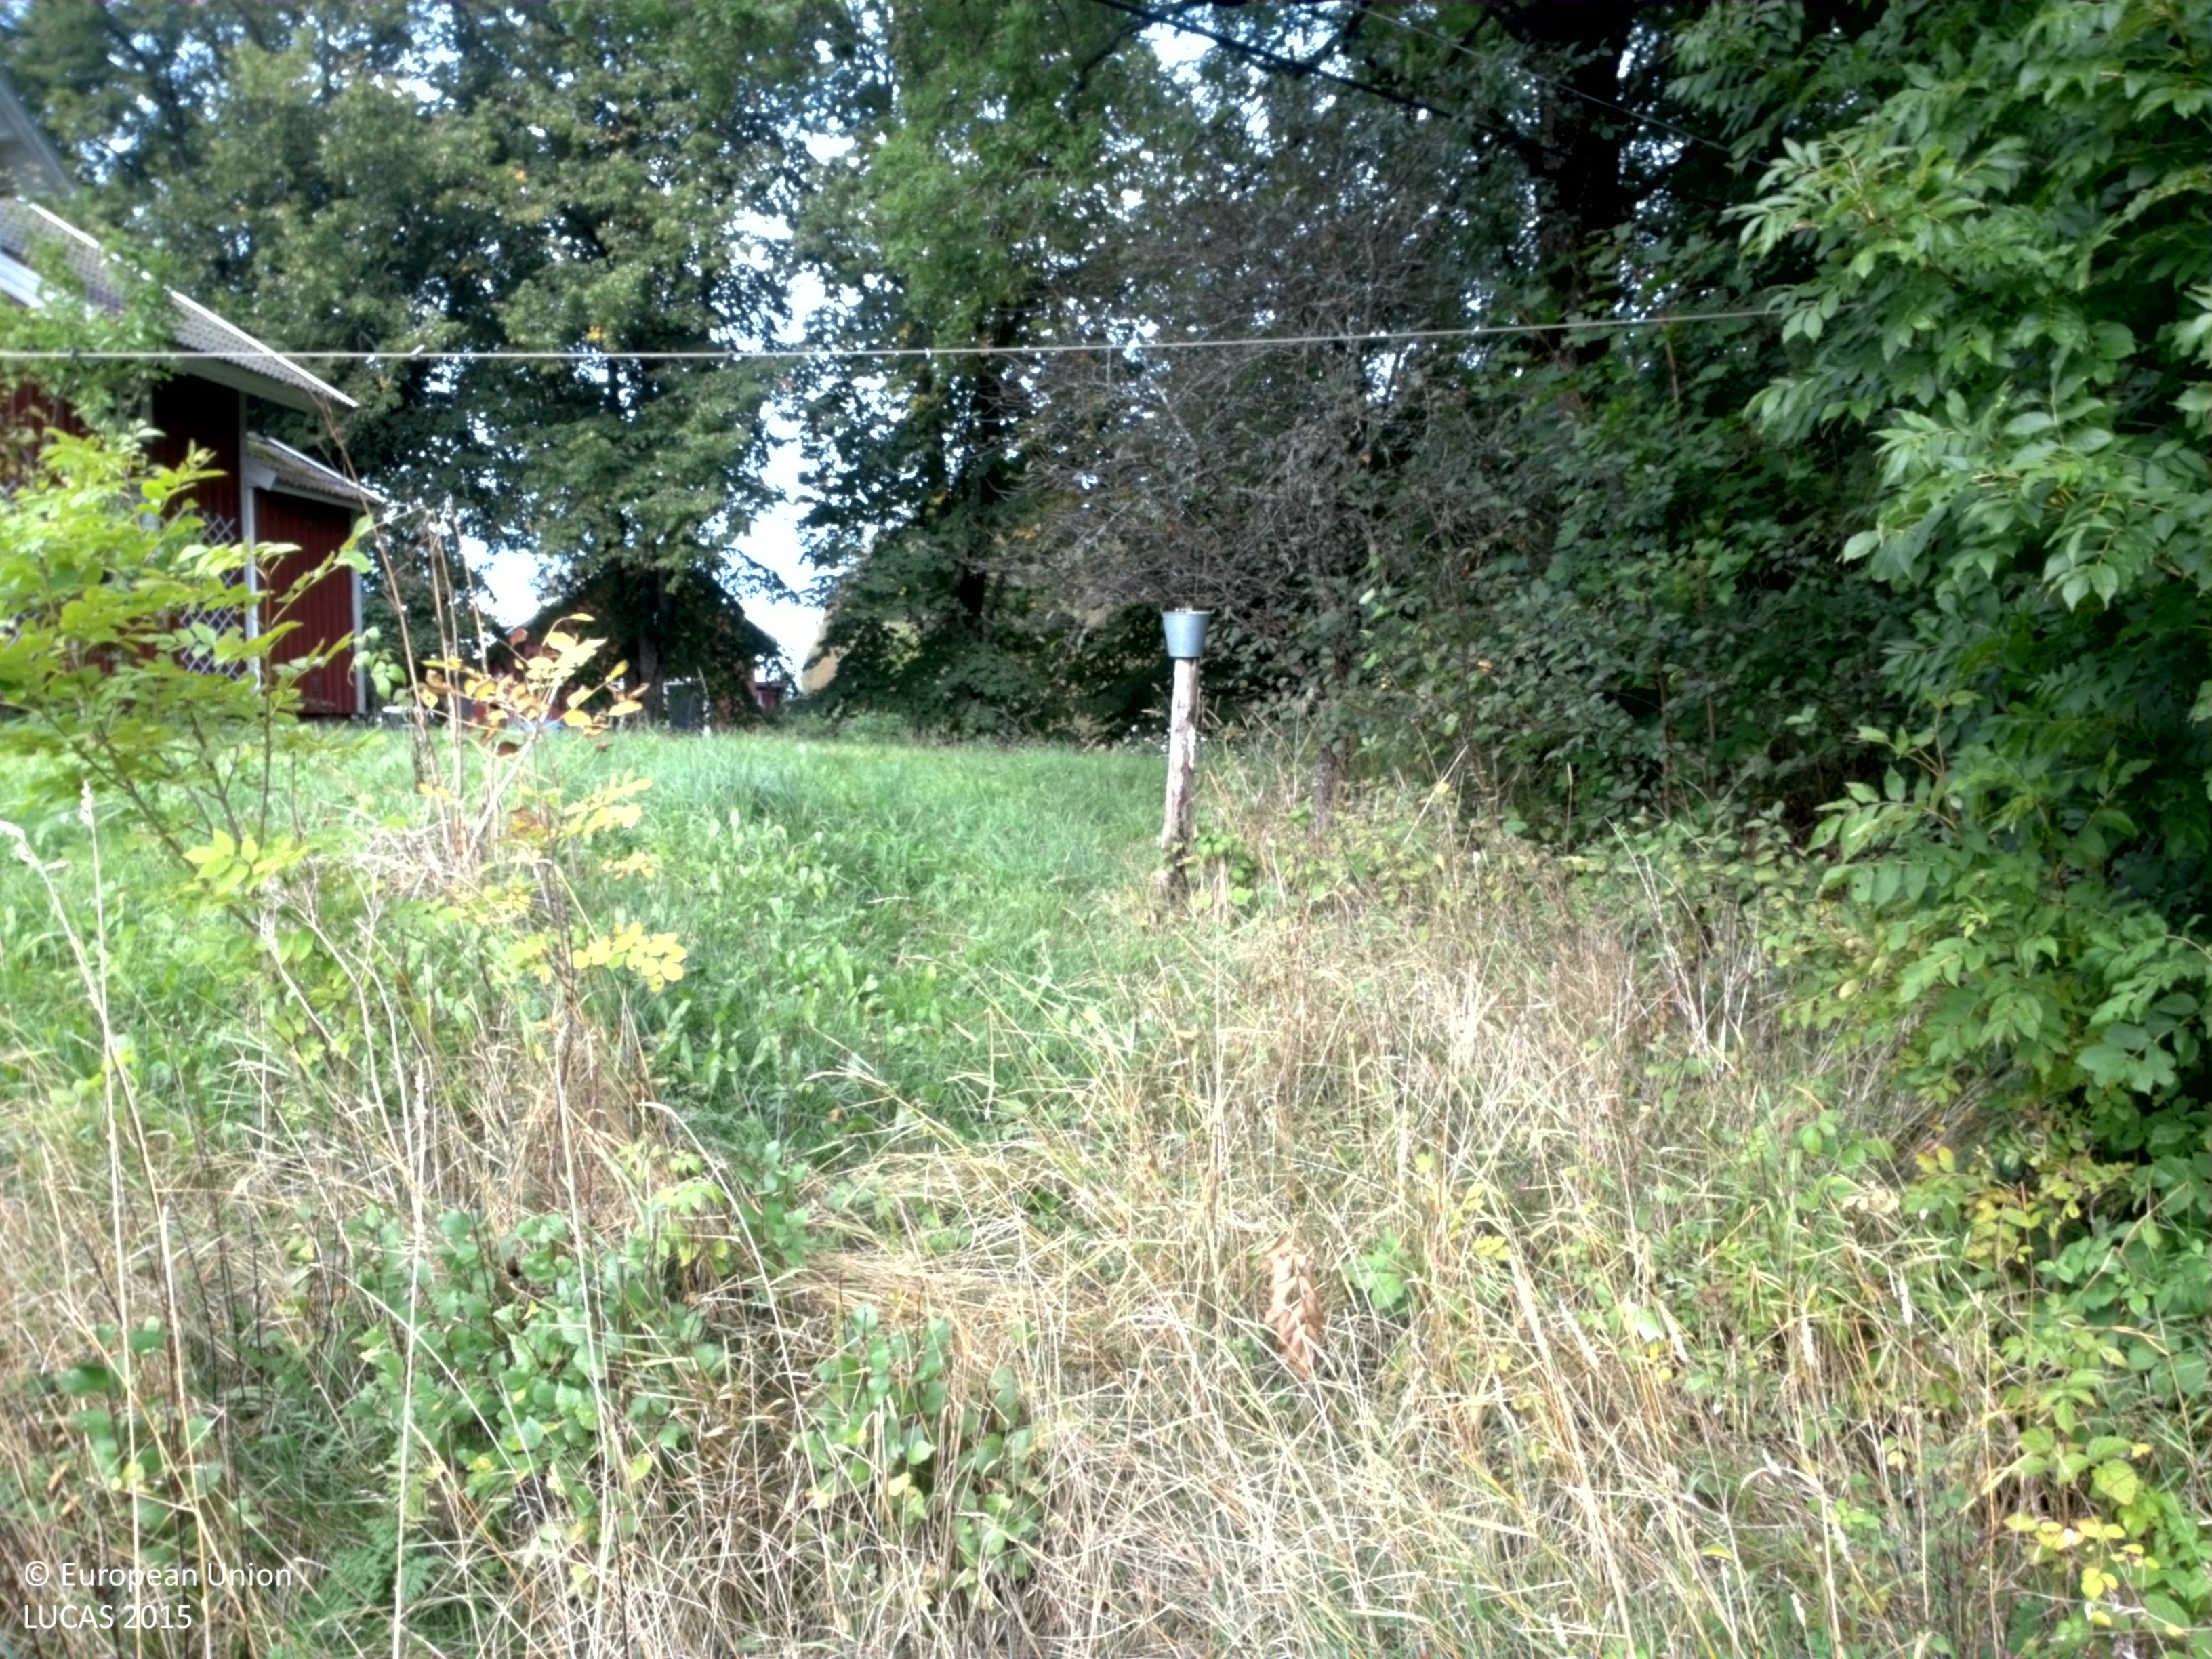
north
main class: Grassland
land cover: Grassland without tree/shrub cover
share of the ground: > 75 %
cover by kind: herbaceous plants 100 %
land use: Agriculture (excluding fallow land and kitchen gardens)
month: September
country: SE
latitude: 58.8700
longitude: 14.3455
